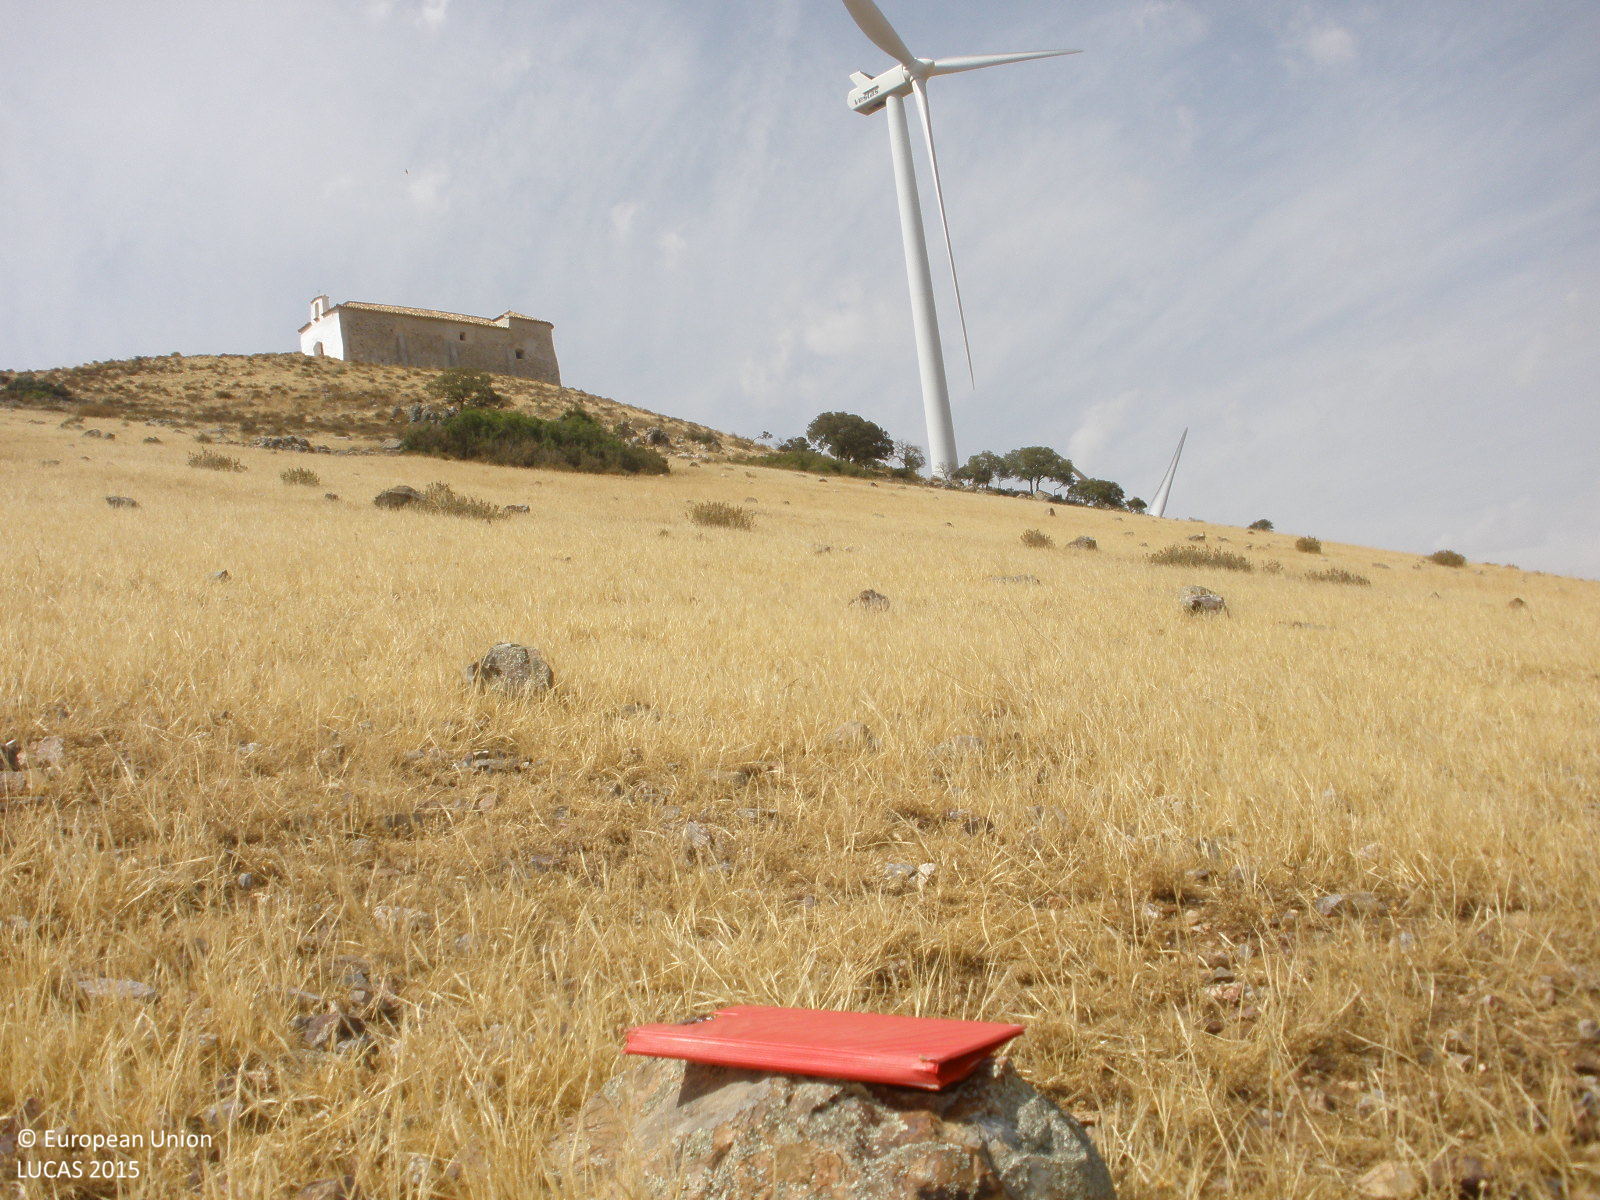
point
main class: Grassland
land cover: Grassland without tree/shrub cover
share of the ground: > 75 %
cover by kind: herbaceous plants 90 %, shrubs 5 %, consolidated bare surface 5 %
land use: Agriculture (excluding fallow land and kitchen gardens)
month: July
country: ES
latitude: 39.7430
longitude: -3.2920
